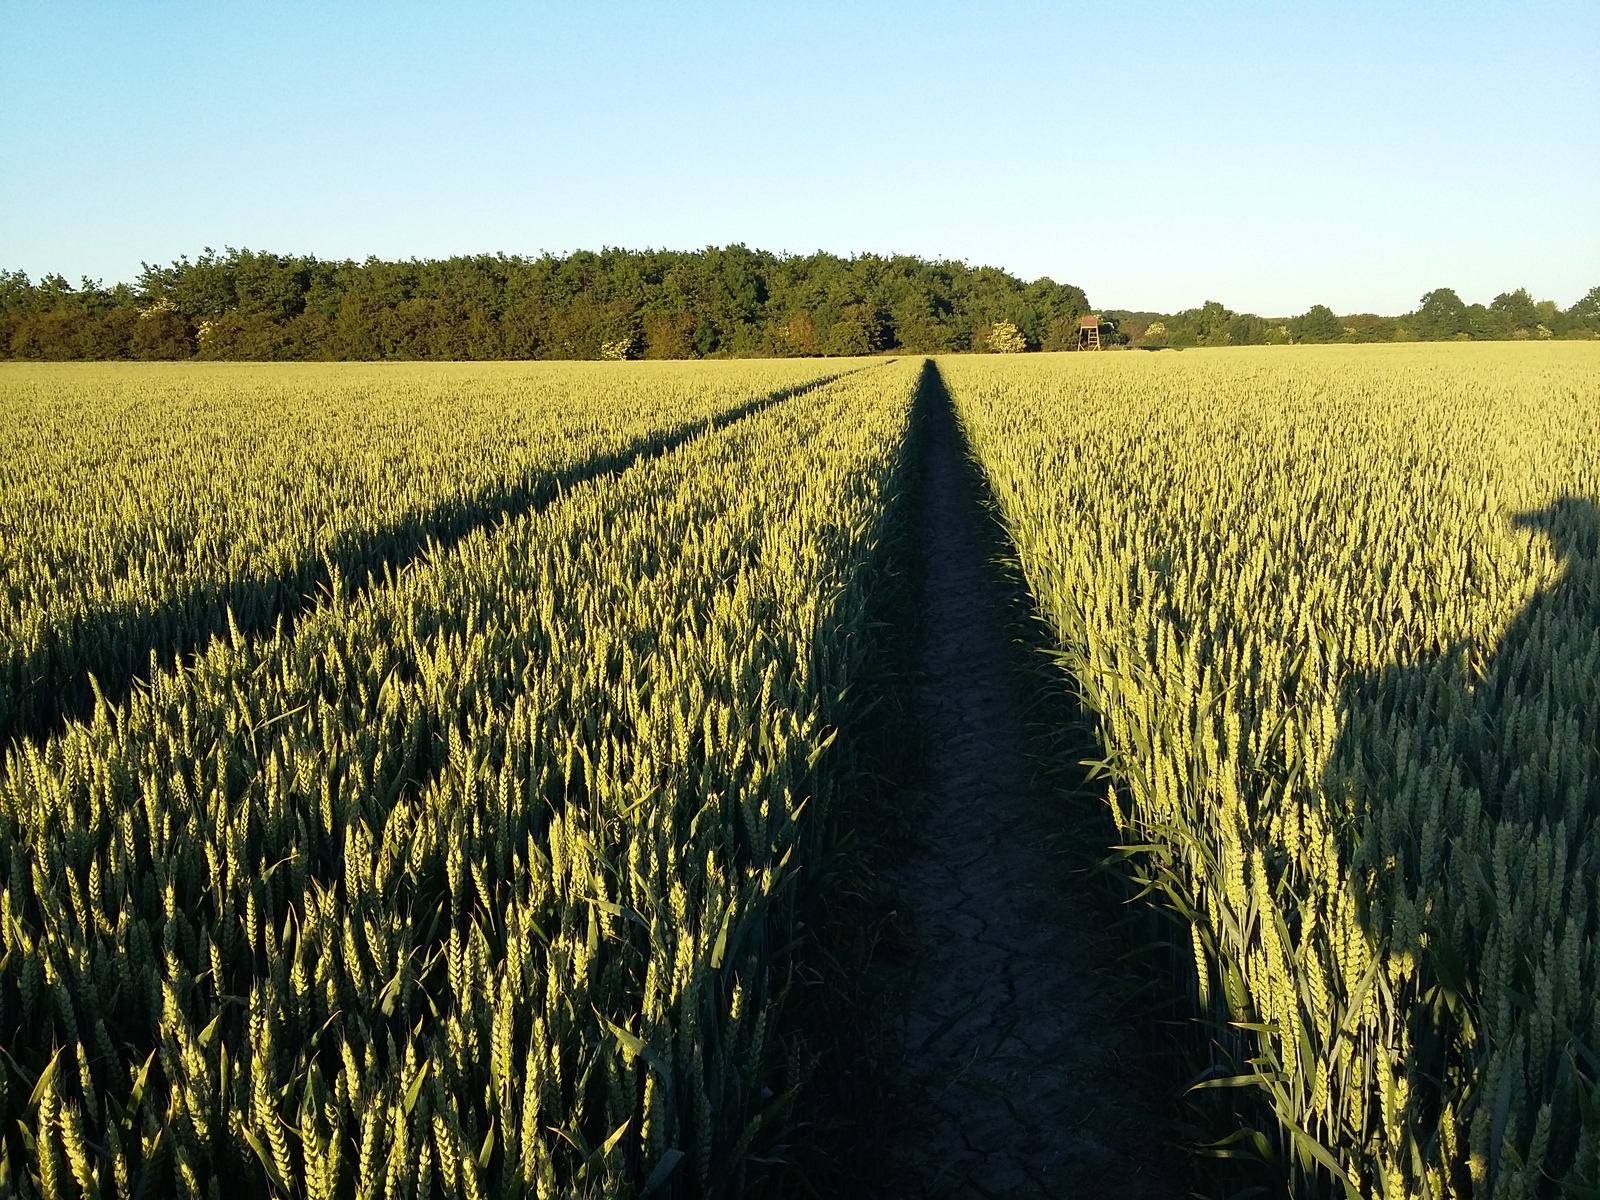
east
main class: Cropland
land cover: Common wheat
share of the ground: > 75 %
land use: Agriculture (excluding fallow land and kitchen gardens)
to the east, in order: Common wheat; Maize; Broadleaved woodland; Artificial constructions in urban areas
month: July
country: DK
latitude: 55.0910
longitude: 12.1451
